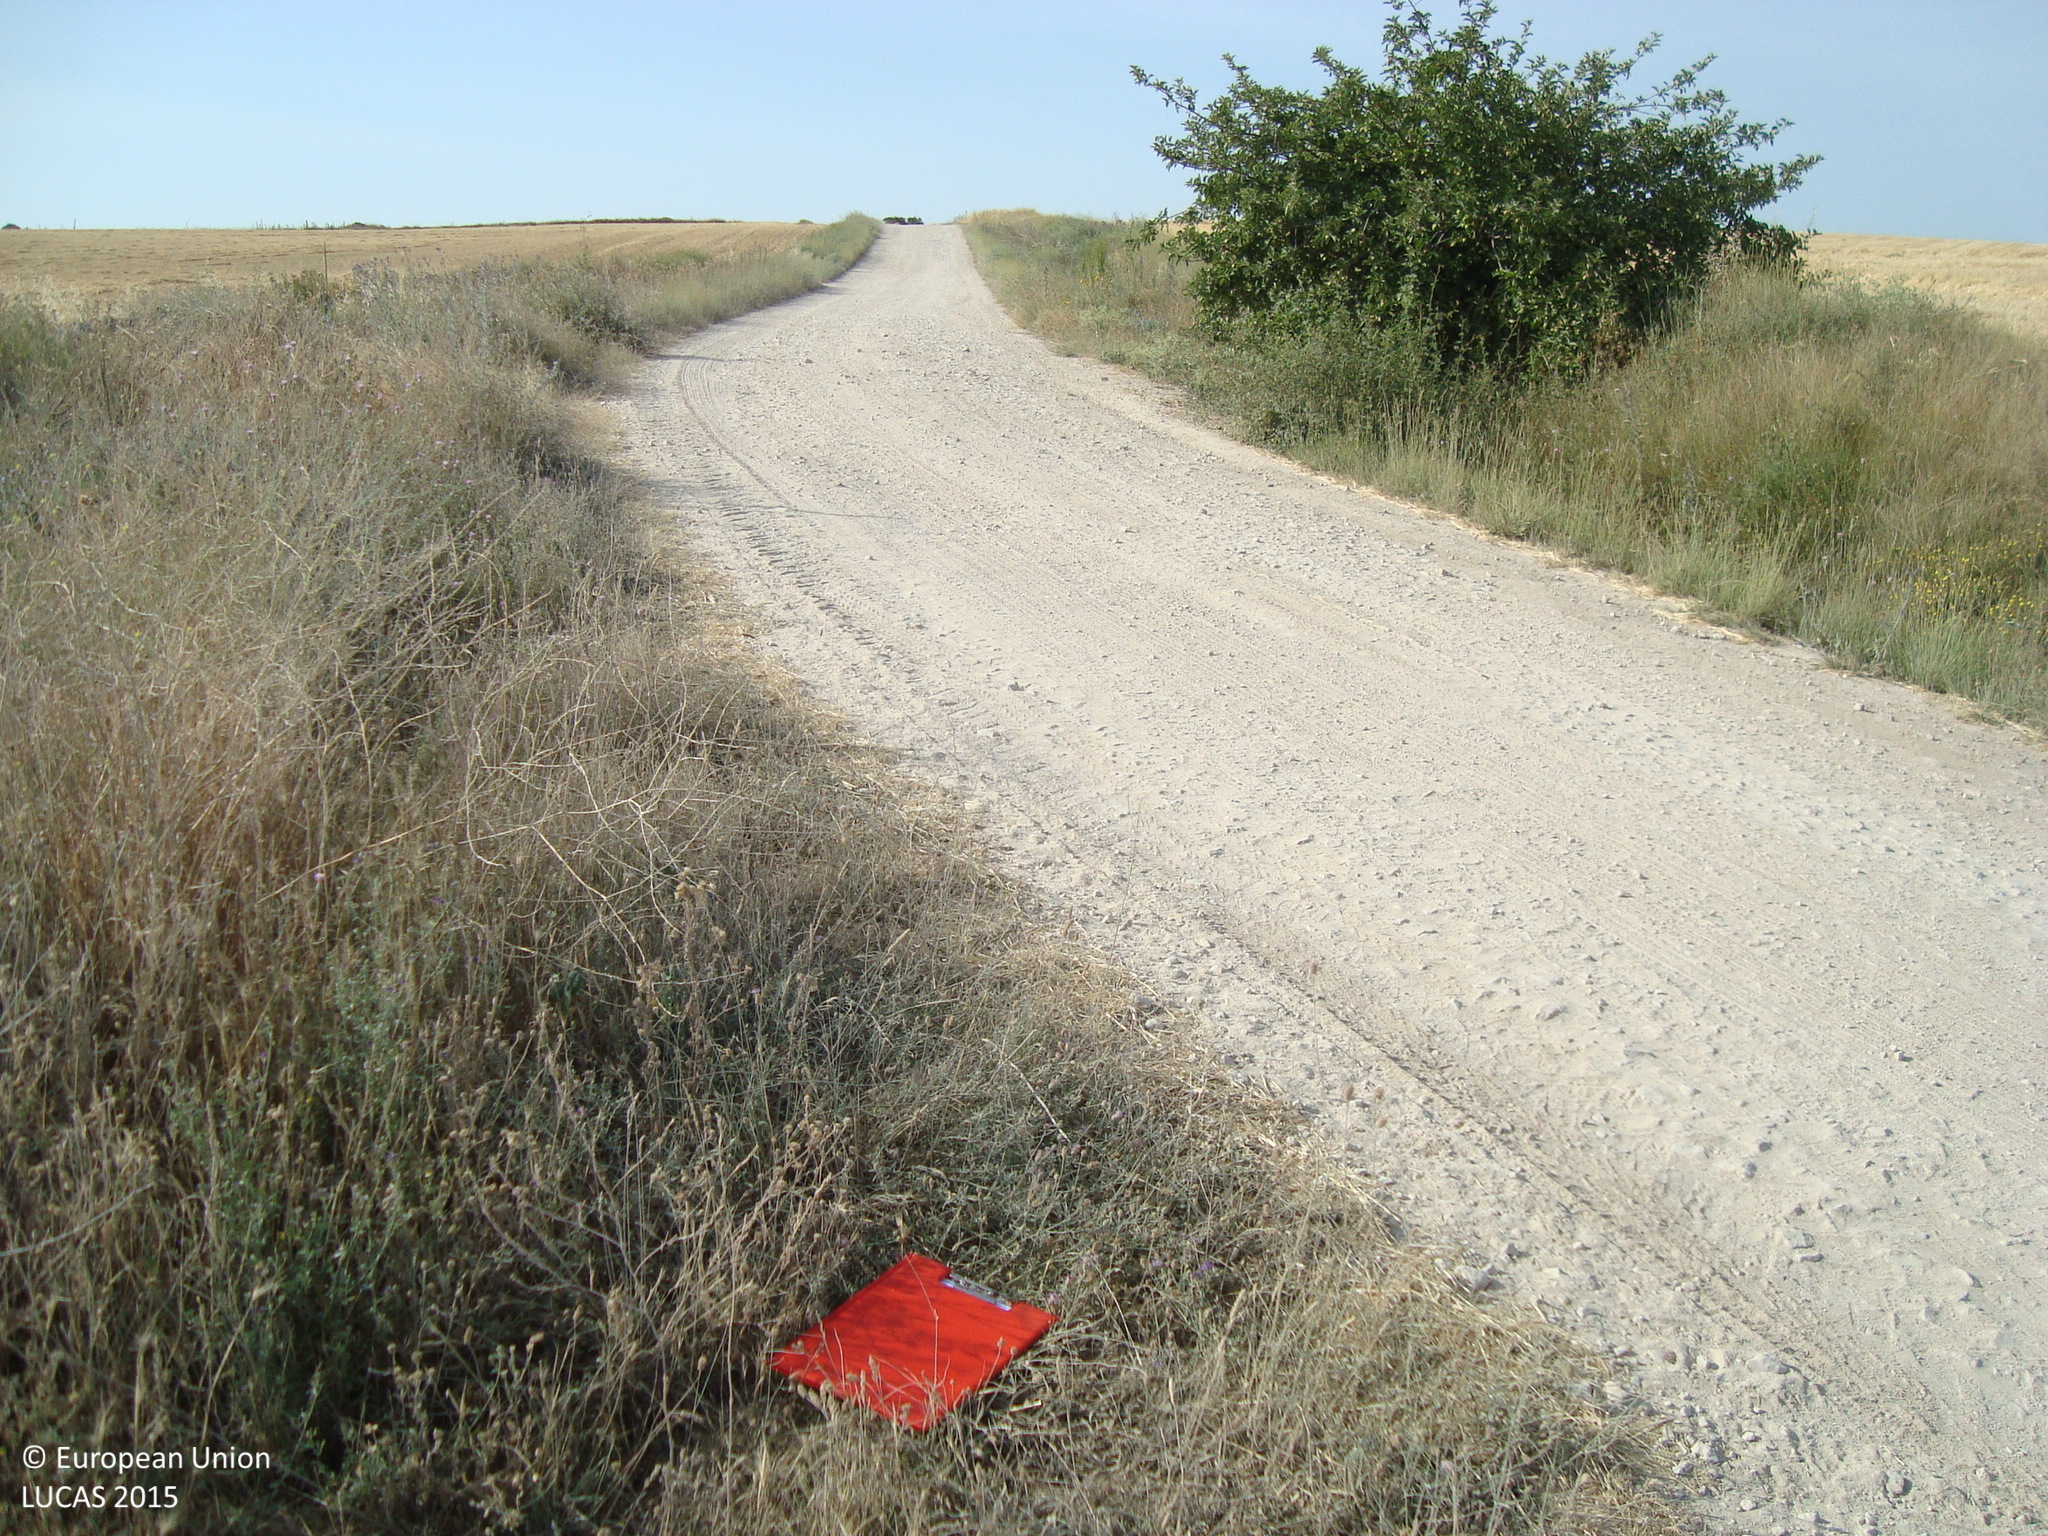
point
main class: Cropland
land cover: Vineyards
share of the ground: 50 - 75 %
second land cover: Other bare soil
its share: > 75 %
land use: Agriculture (excluding fallow land and kitchen gardens)
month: July
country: ES
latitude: 41.7341
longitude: -4.2369
